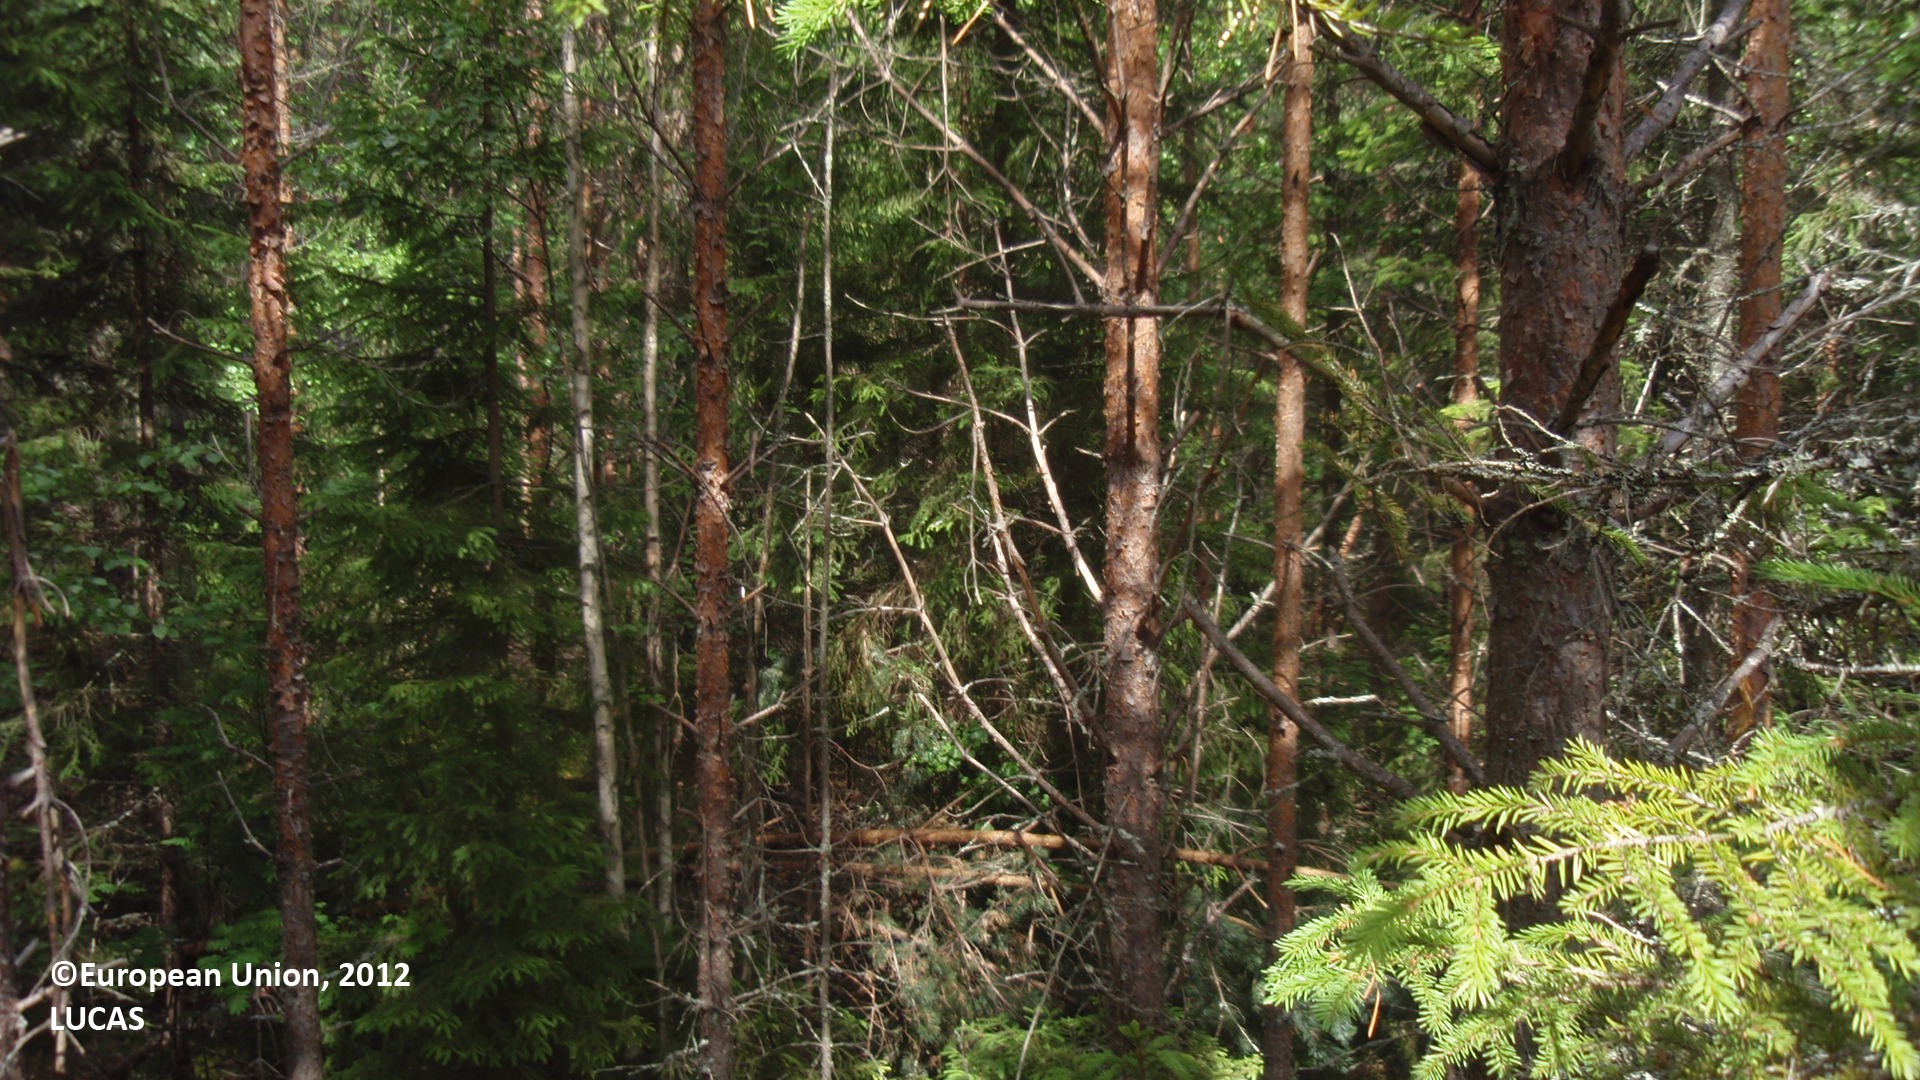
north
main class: Woodland
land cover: Spruce dominated mixed woodland
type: boreal forest
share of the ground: 25 - 50 %
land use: Semi-natural and natural areas not in use
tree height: > 5 m
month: July
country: FI
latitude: 61.6208
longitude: 28.1725
